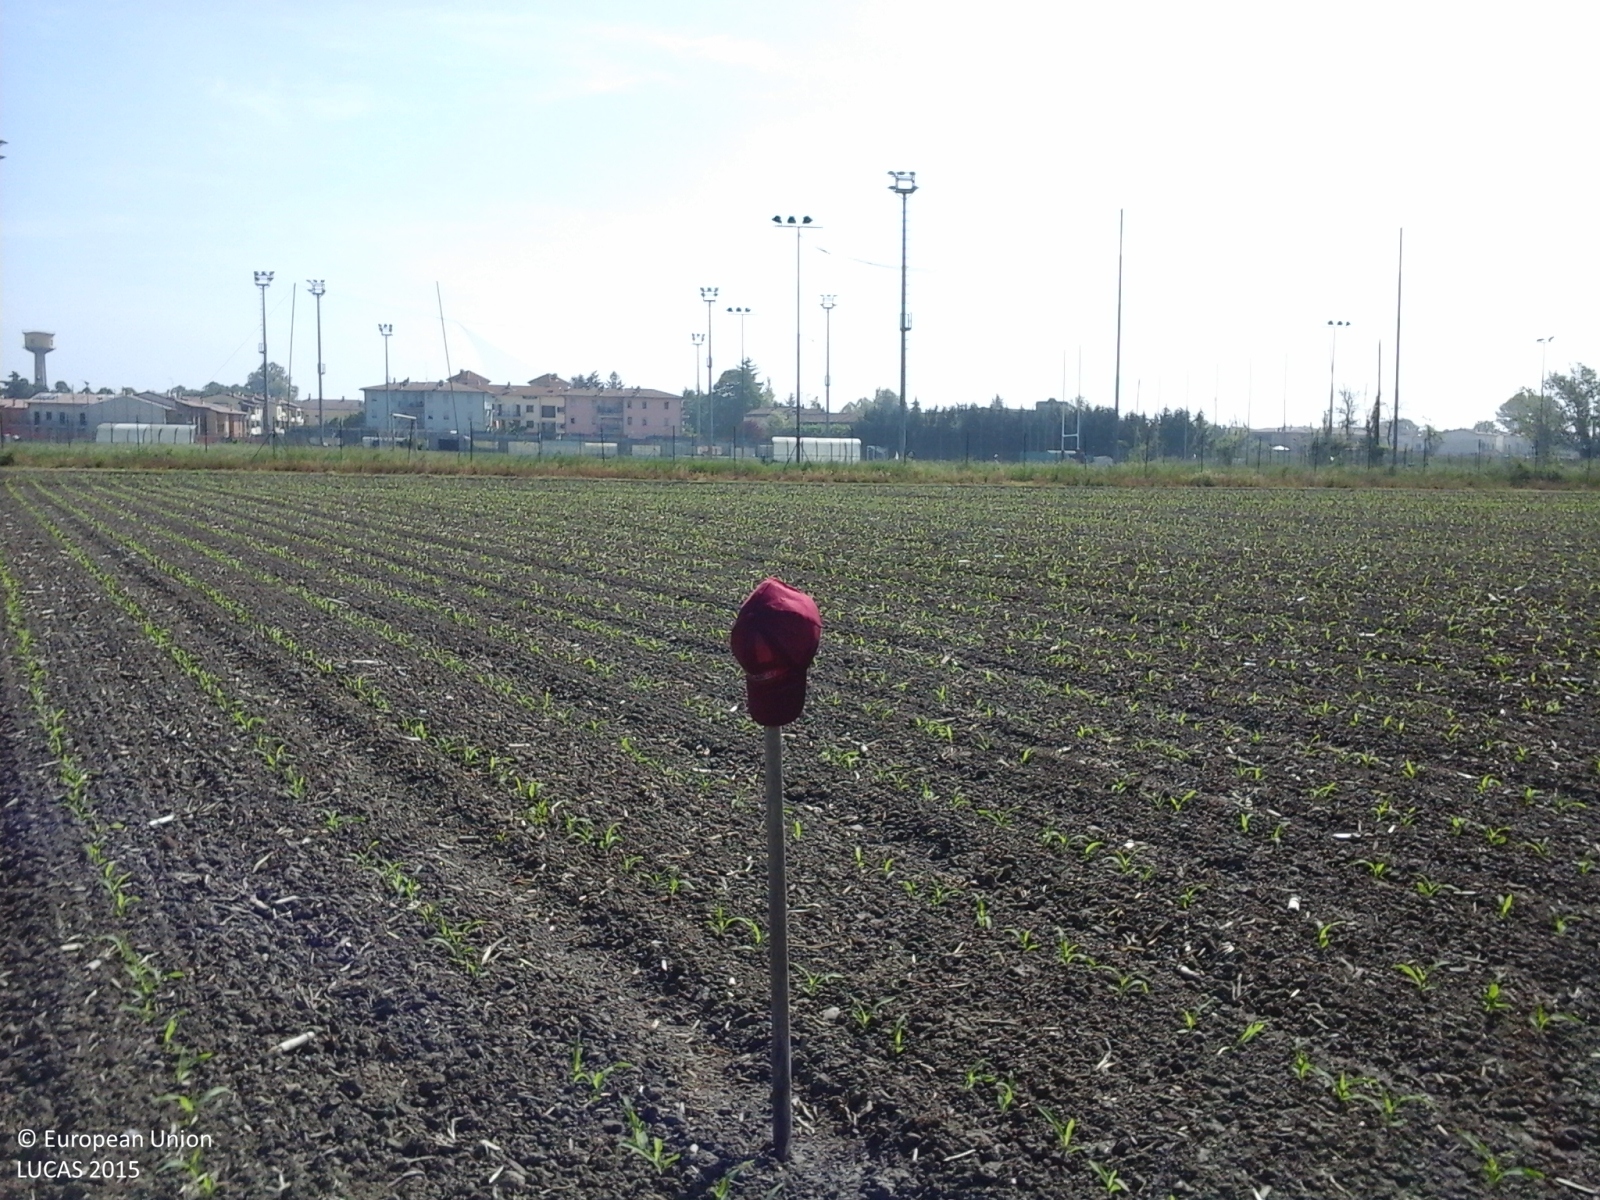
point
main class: Cropland
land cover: Maize
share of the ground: < 10 %
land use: Agriculture (excluding fallow land and kitchen gardens)
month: May
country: IT
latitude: 44.9990
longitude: 9.6075
